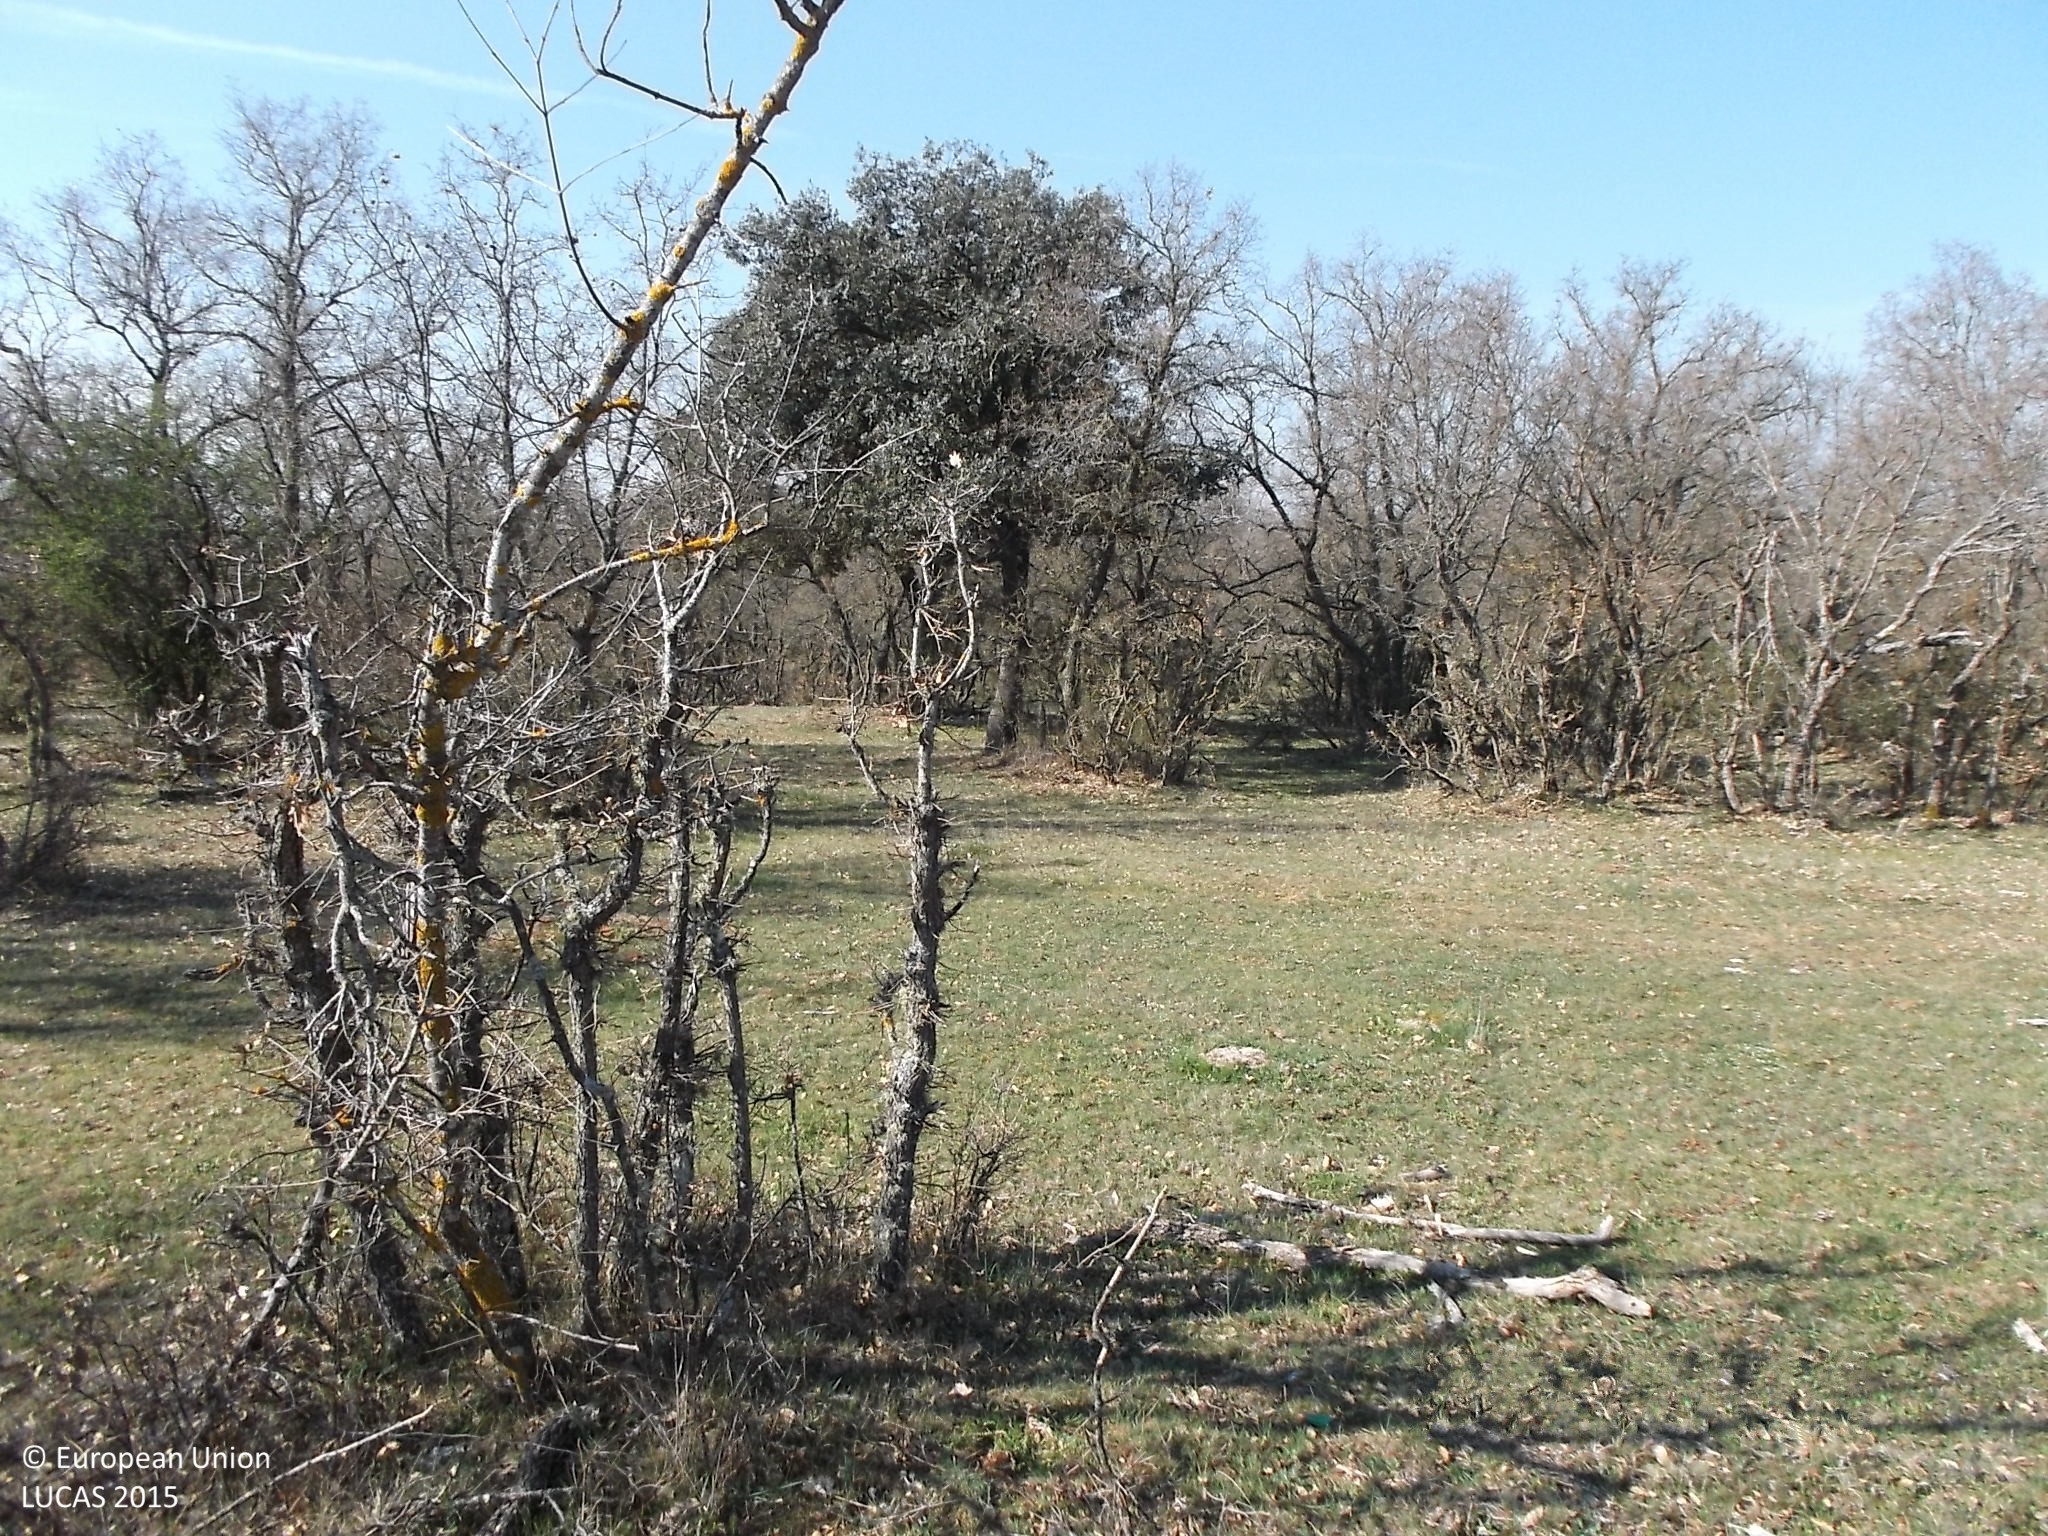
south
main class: Woodland
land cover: Broadleaved woodland
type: broadleaved evergreen forest
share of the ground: 25 - 50 %
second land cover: Grassland without tree/shrub cover
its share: 50 - 75 %
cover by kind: broadleaved forest trees 50 %, herbaceous plants 50 %
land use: Forestry
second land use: Agriculture (excluding fallow land and kitchen gardens)
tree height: < 5 m
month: April
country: ES
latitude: 40.8782
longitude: -5.8747
